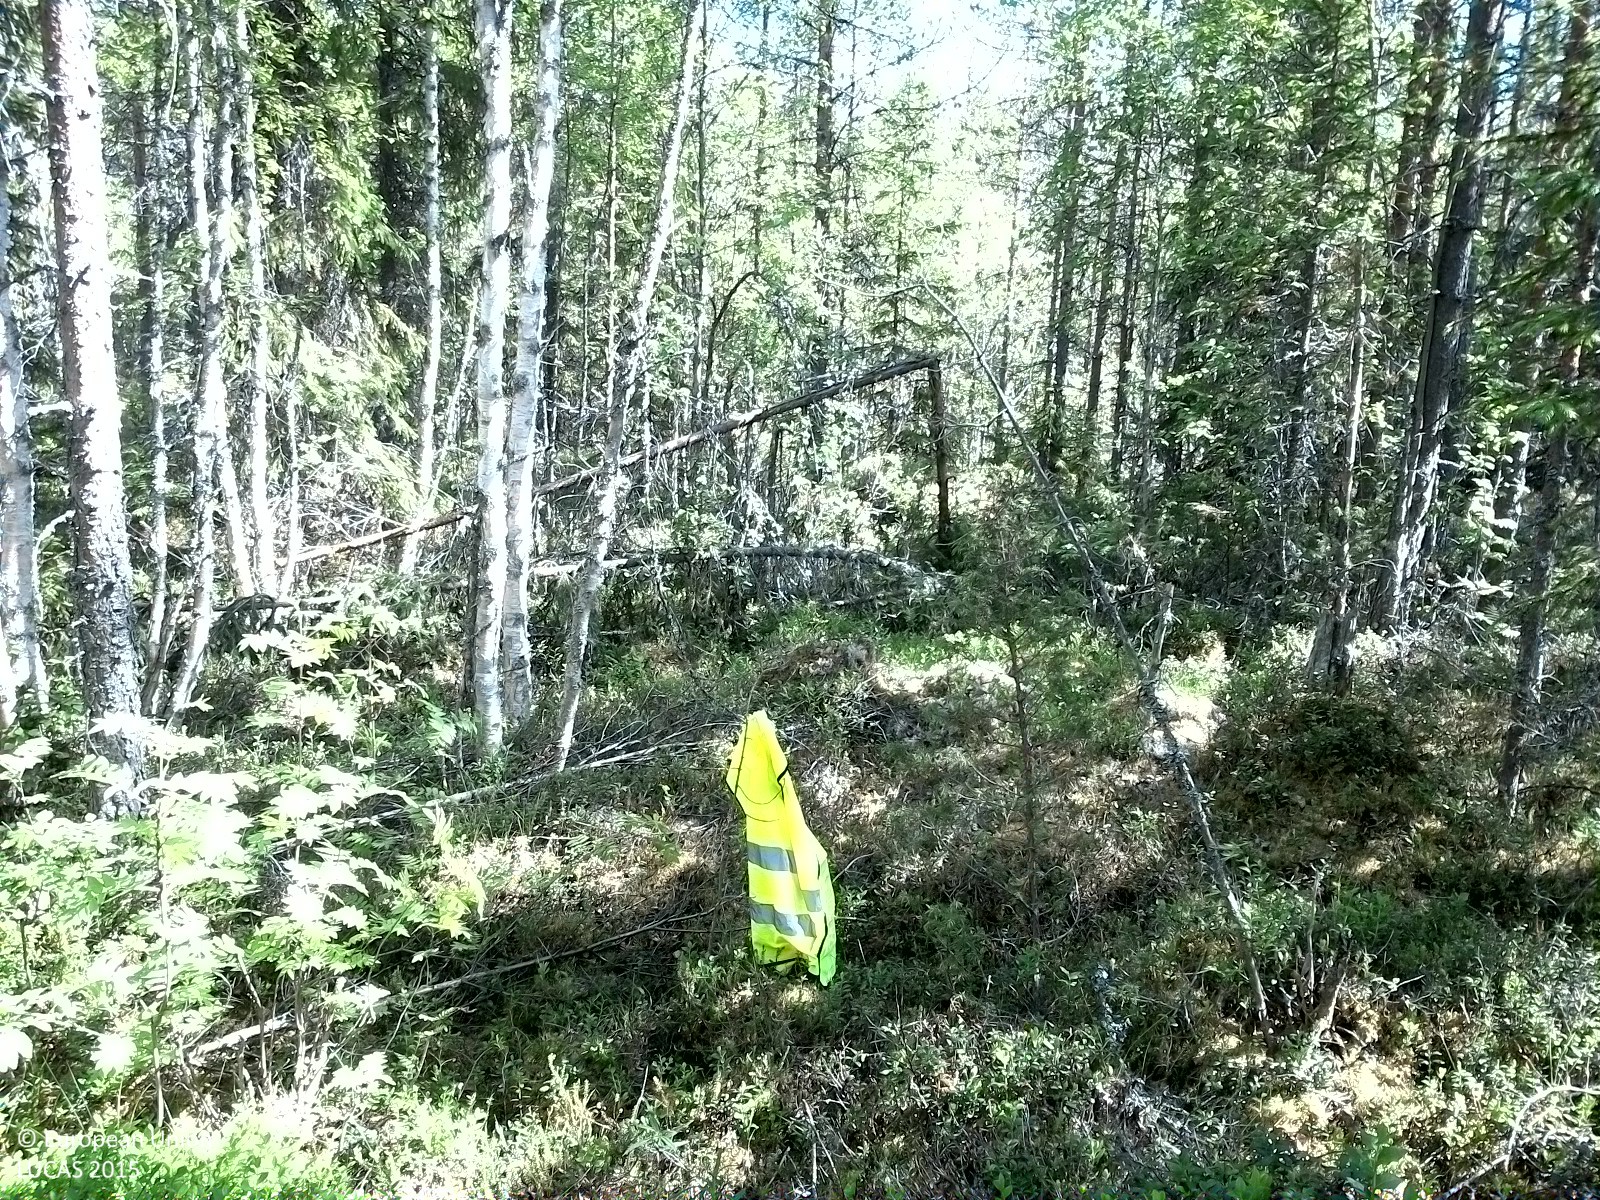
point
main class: Woodland
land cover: Other mixed woodland
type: boreal forest
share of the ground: 25 - 50 %
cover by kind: broadleaved forest trees 30 %, shrubs 30 %, coniferous forest trees 20 %, lichens and mosses 20 %
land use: Forestry
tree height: > 5 m
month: June
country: SE
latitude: 62.1682
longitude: 16.4127
